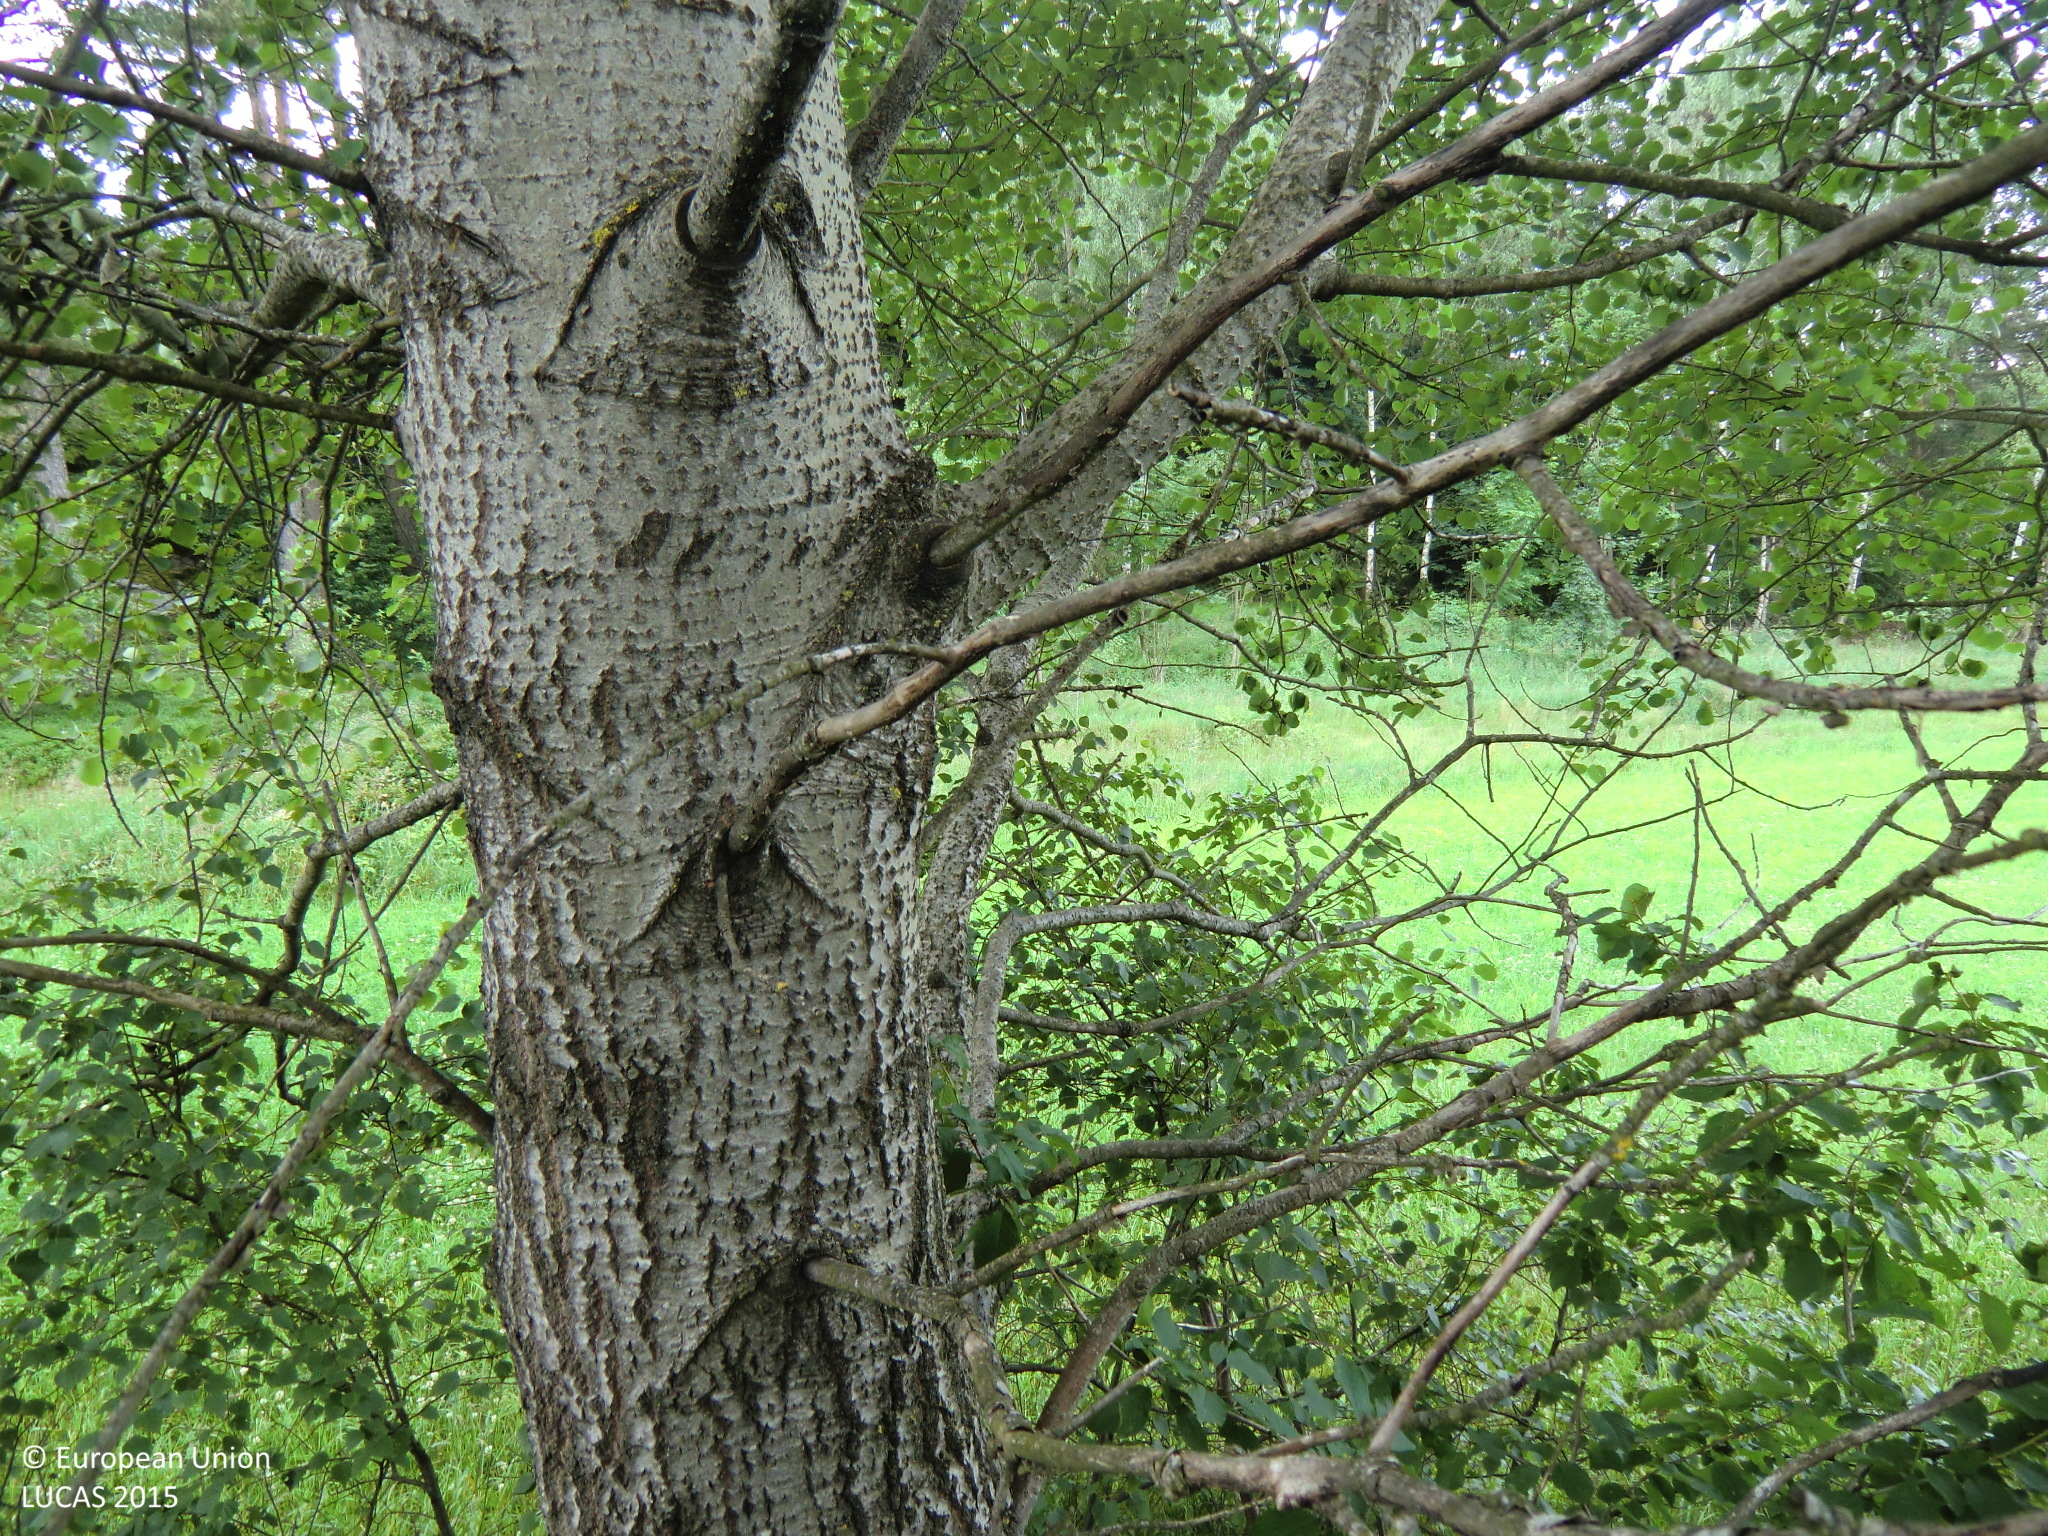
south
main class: Woodland
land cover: Broadleaved woodland
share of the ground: > 75 %
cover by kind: broadleaved forest trees 85 %, herbaceous plants 5 %, lichens and mosses 5 %, consolidated bare surface 5 %
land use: Forestry
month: June
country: AT
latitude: 48.5249
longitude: 14.9980
